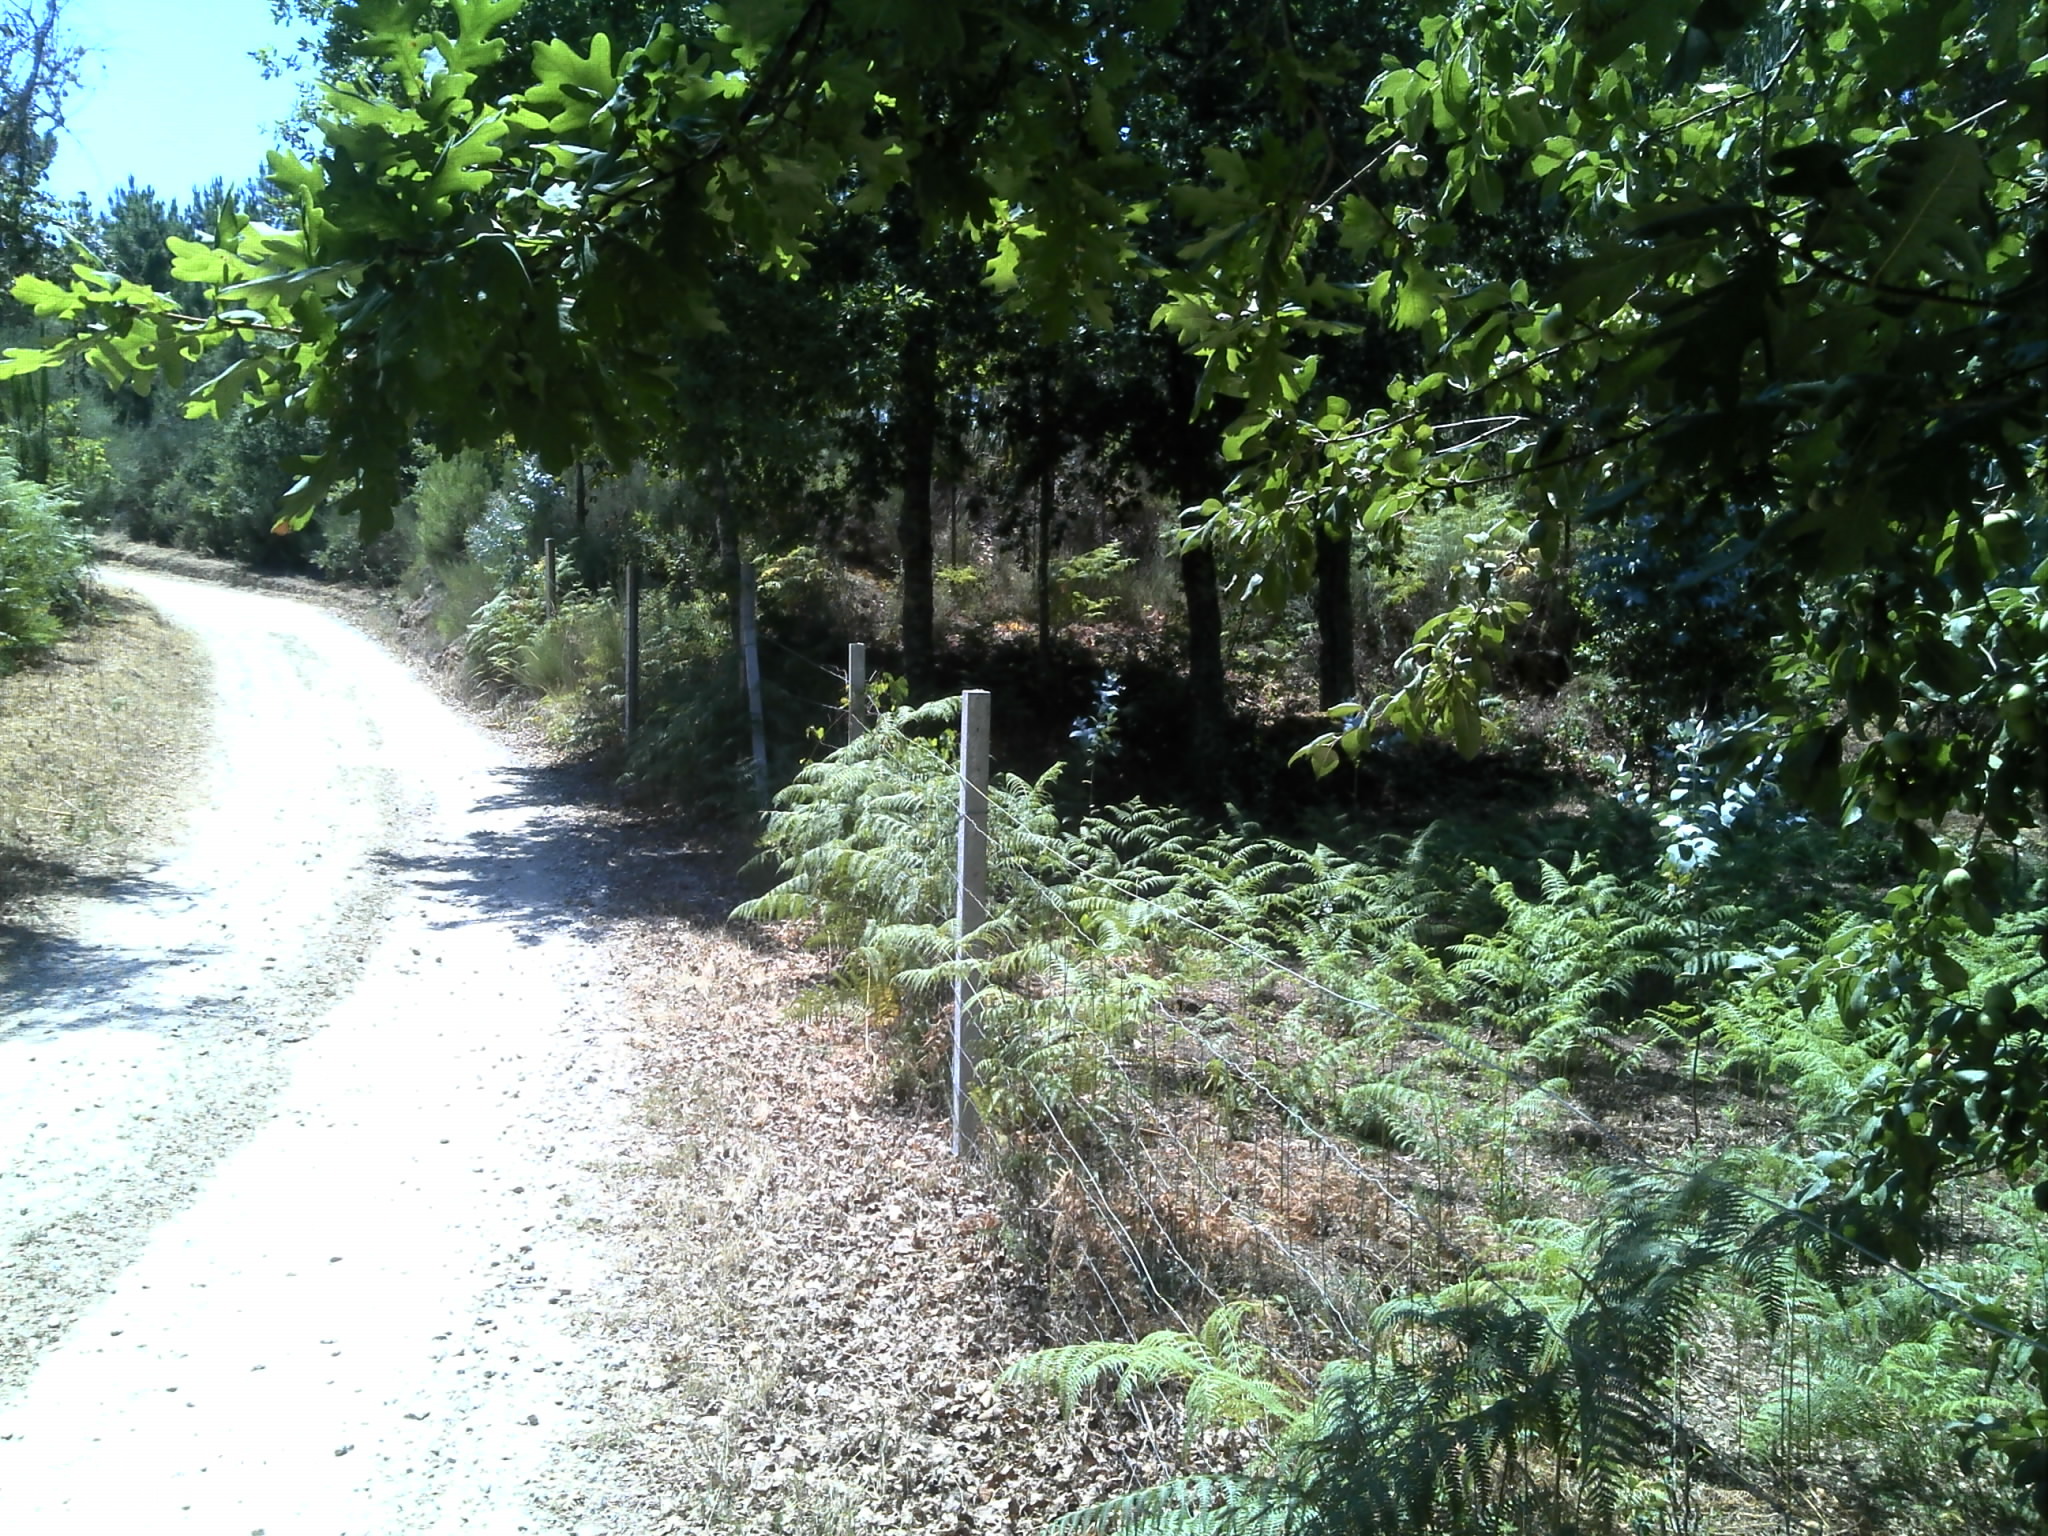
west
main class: Woodland
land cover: Broadleaved woodland
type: thermophilous deciduous forest
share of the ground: 50 - 75 %
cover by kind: broadleaved forest trees 70 %, shrubs 15 %, unconsolidated bare surface 15 %
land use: Forestry
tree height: > 5 m
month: July
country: PT
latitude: 40.3503
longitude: -7.9573
